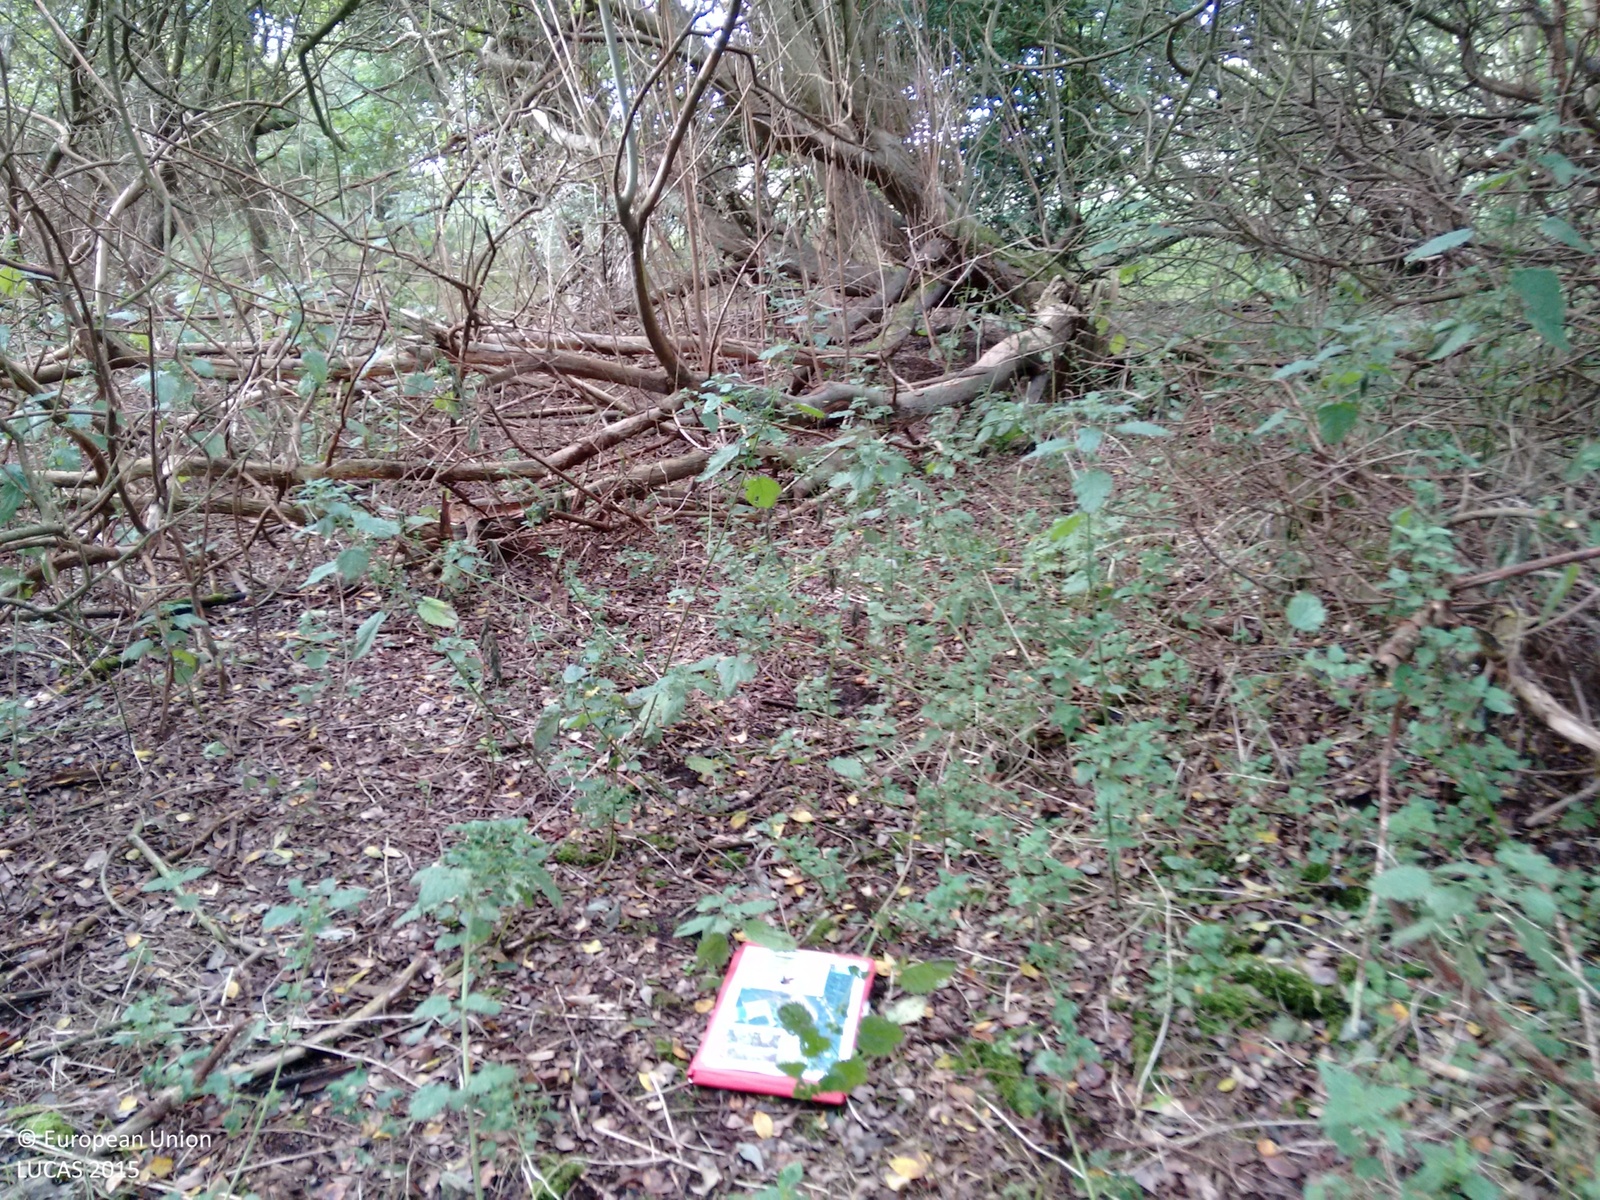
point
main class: Woodland
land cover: Other mixed woodland
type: mesophytic deciduous forest
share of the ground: > 75 %
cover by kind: broadleaved forest trees 75 %, coniferous forest trees 25 %
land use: Forestry
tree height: > 5 m
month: September
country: GB
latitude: 52.7353
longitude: 1.6739
